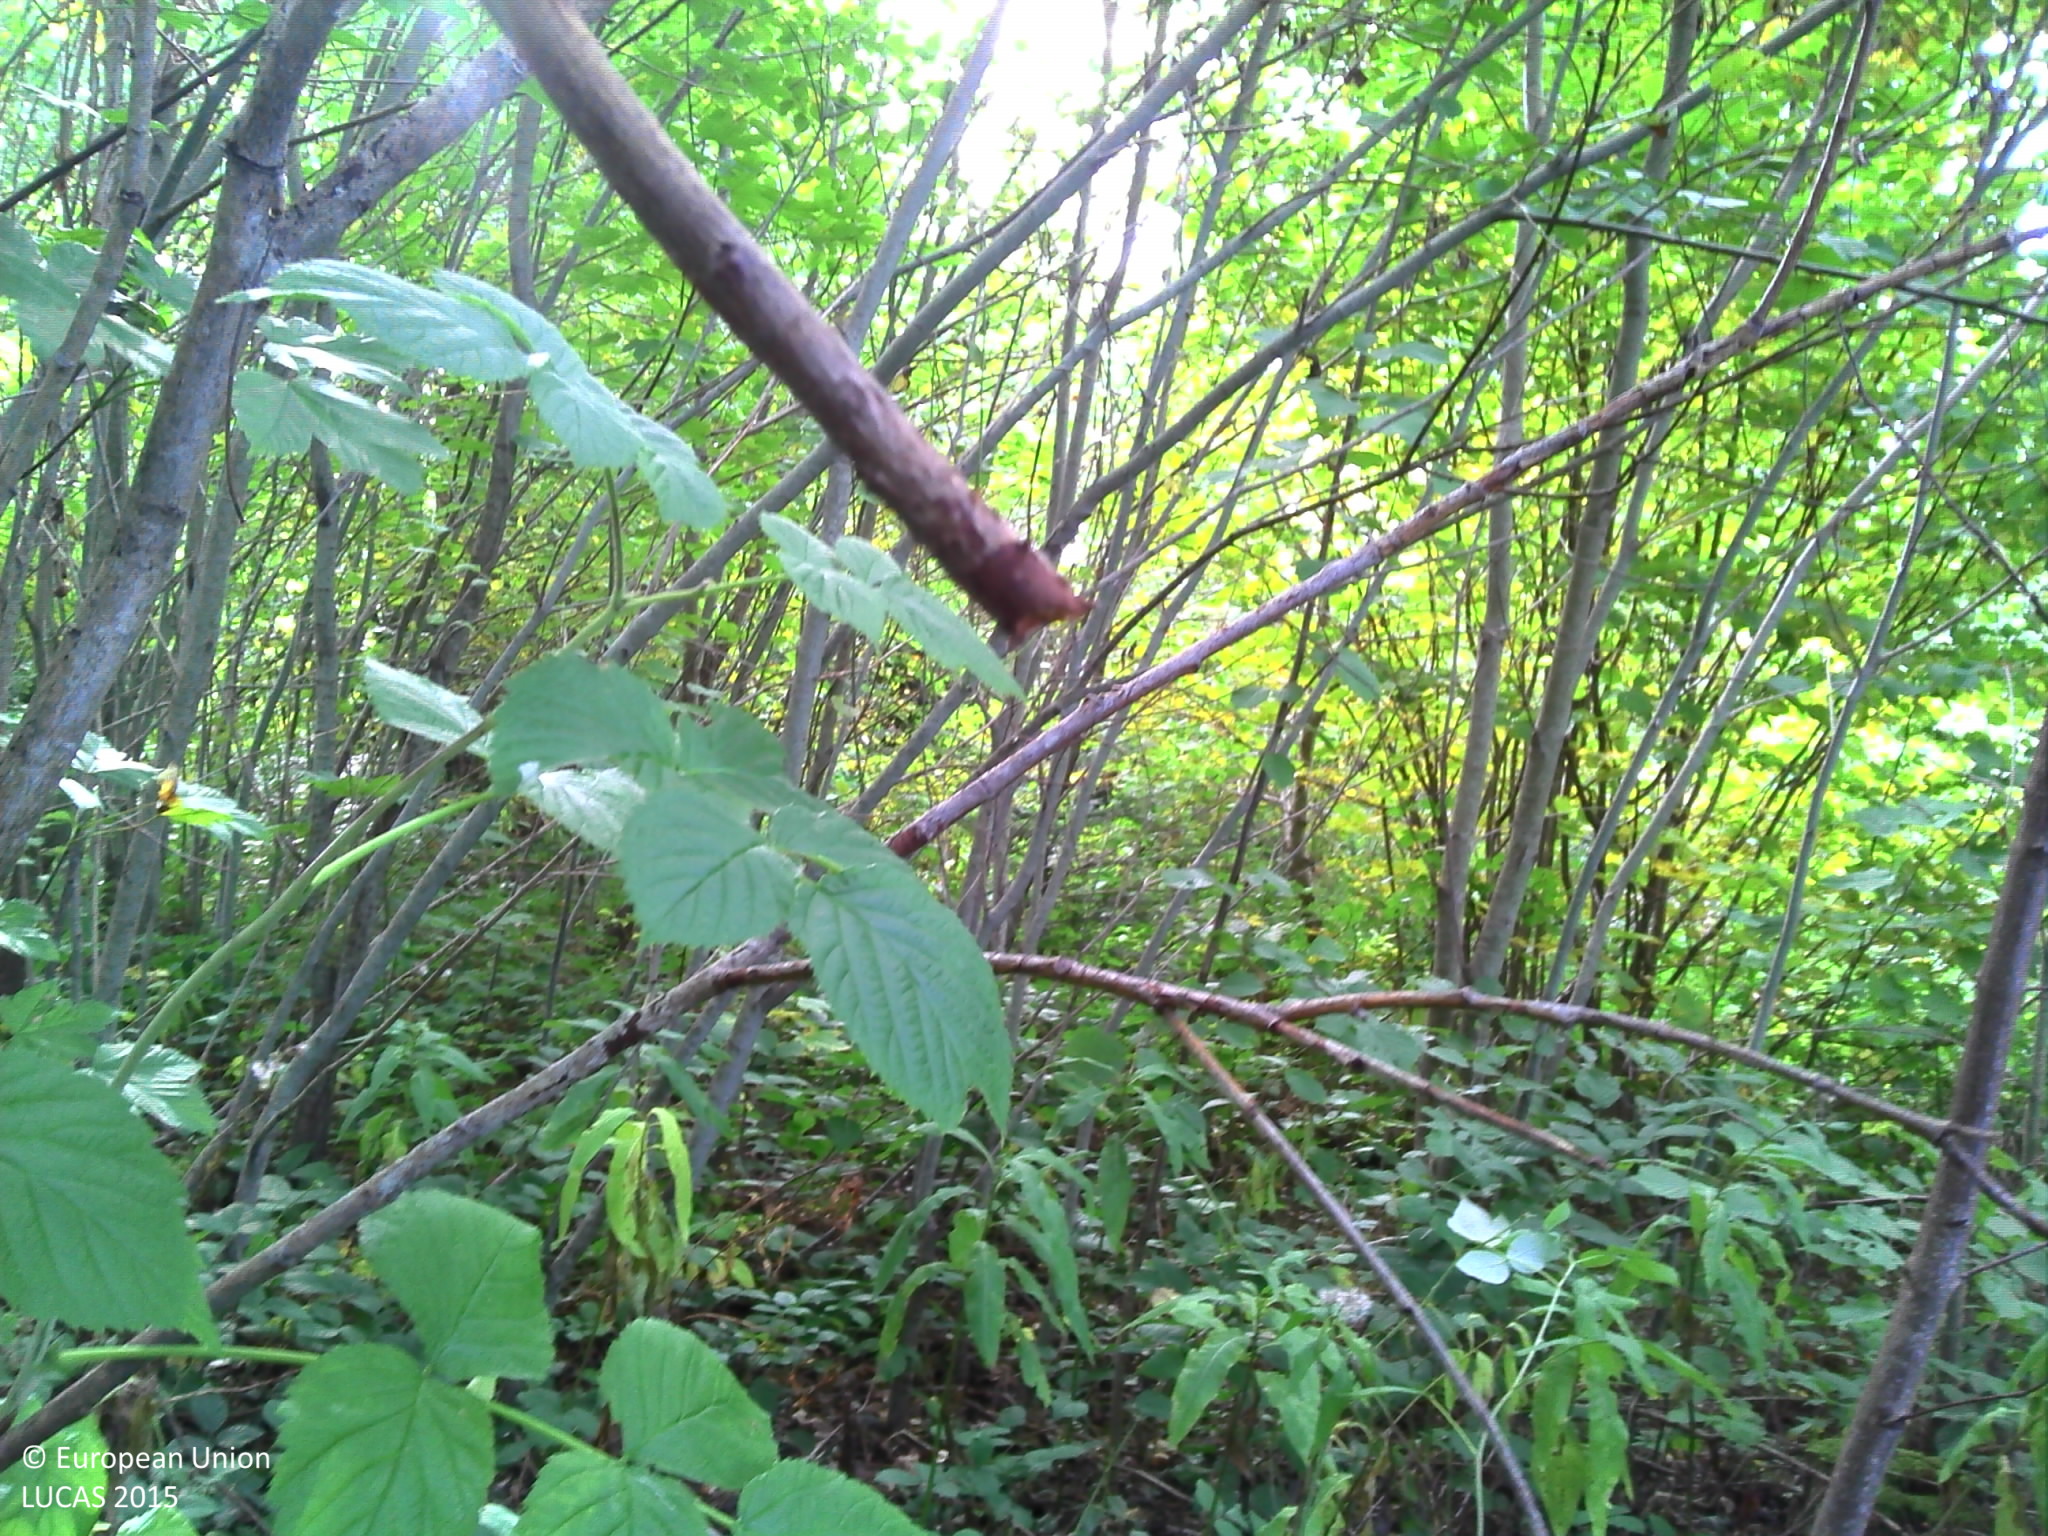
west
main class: Woodland
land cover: Broadleaved woodland
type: mesophytic deciduous forest
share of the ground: 50 - 75 %
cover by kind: broadleaved forest trees 75 %, shrubs 25 %
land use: Forestry
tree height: > 5 m
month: October
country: FR
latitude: 47.0283
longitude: 6.3574
